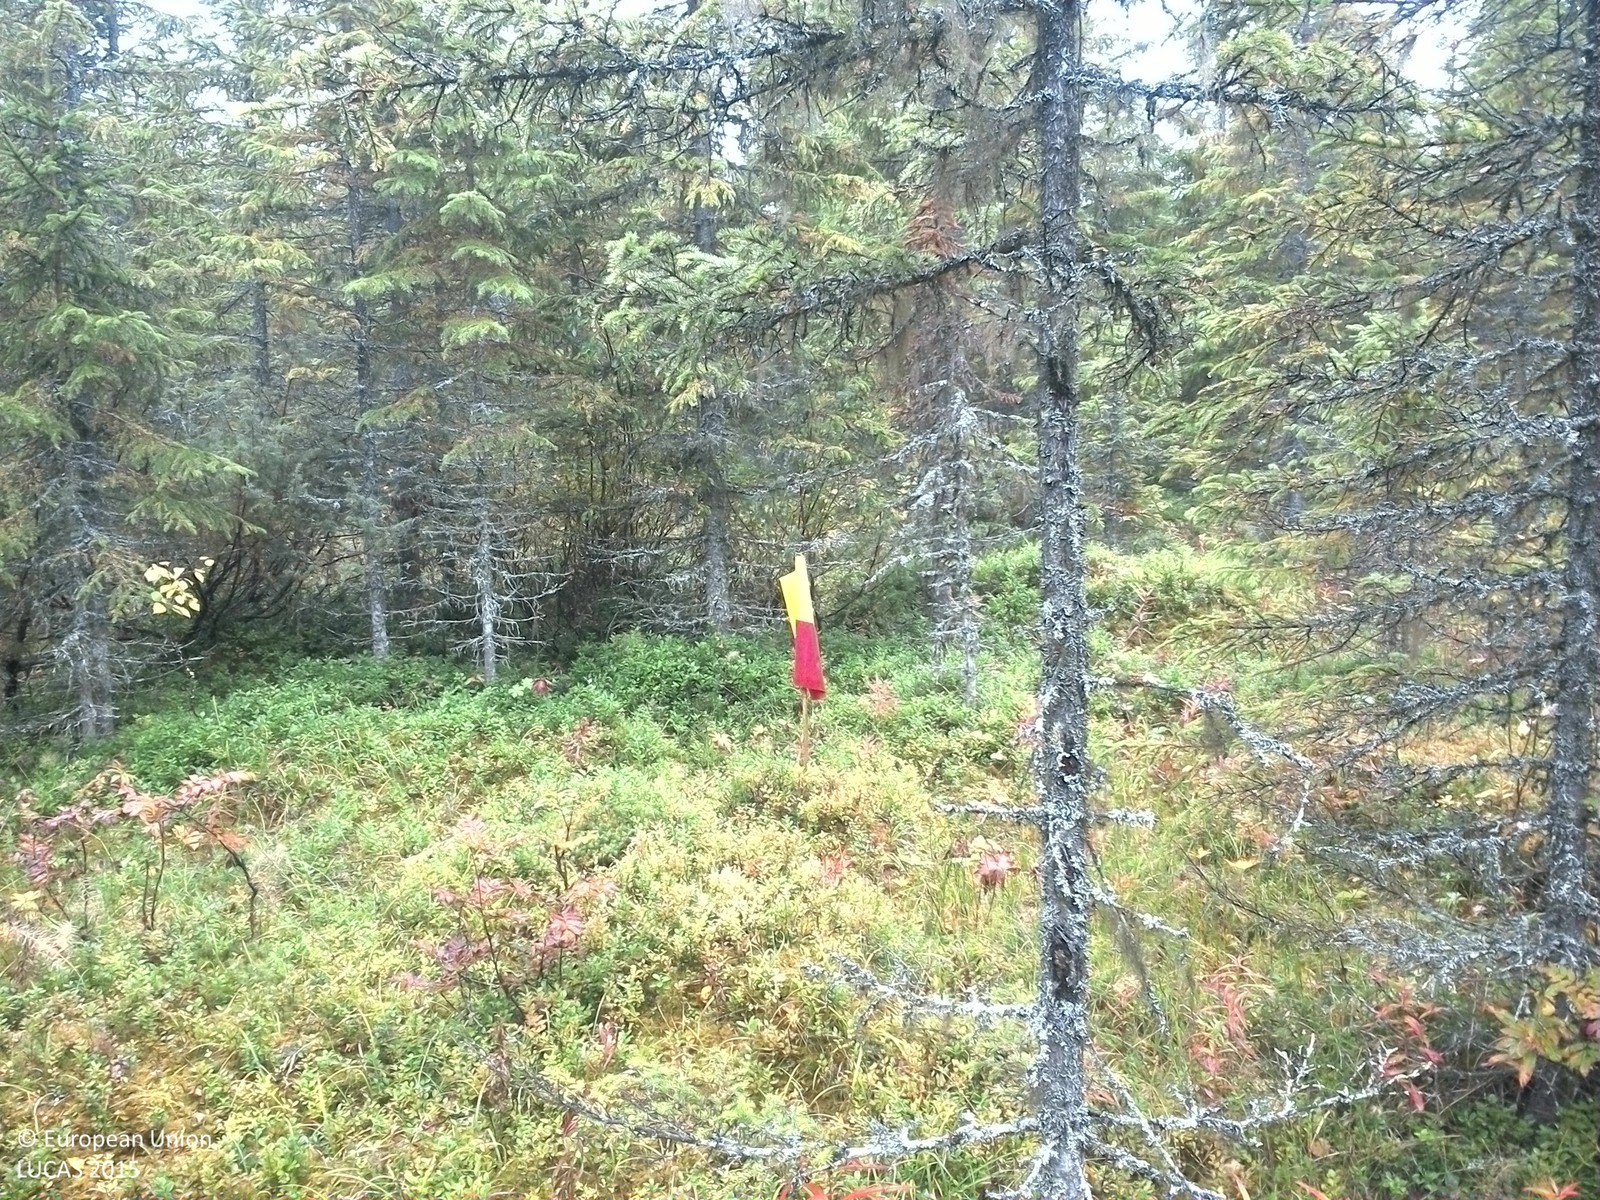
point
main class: Woodland
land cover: Spruce dominated coniferous woodland
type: boreal forest
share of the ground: 50 - 75 %
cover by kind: coniferous forest trees 60 %, shrubs 20 %, lichens and mosses 10 %, broadleaved forest trees 5 %, herbaceous plants 5 %
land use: Forestry
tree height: > 5 m
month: September
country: SE
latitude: 63.6206
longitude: 15.8442
